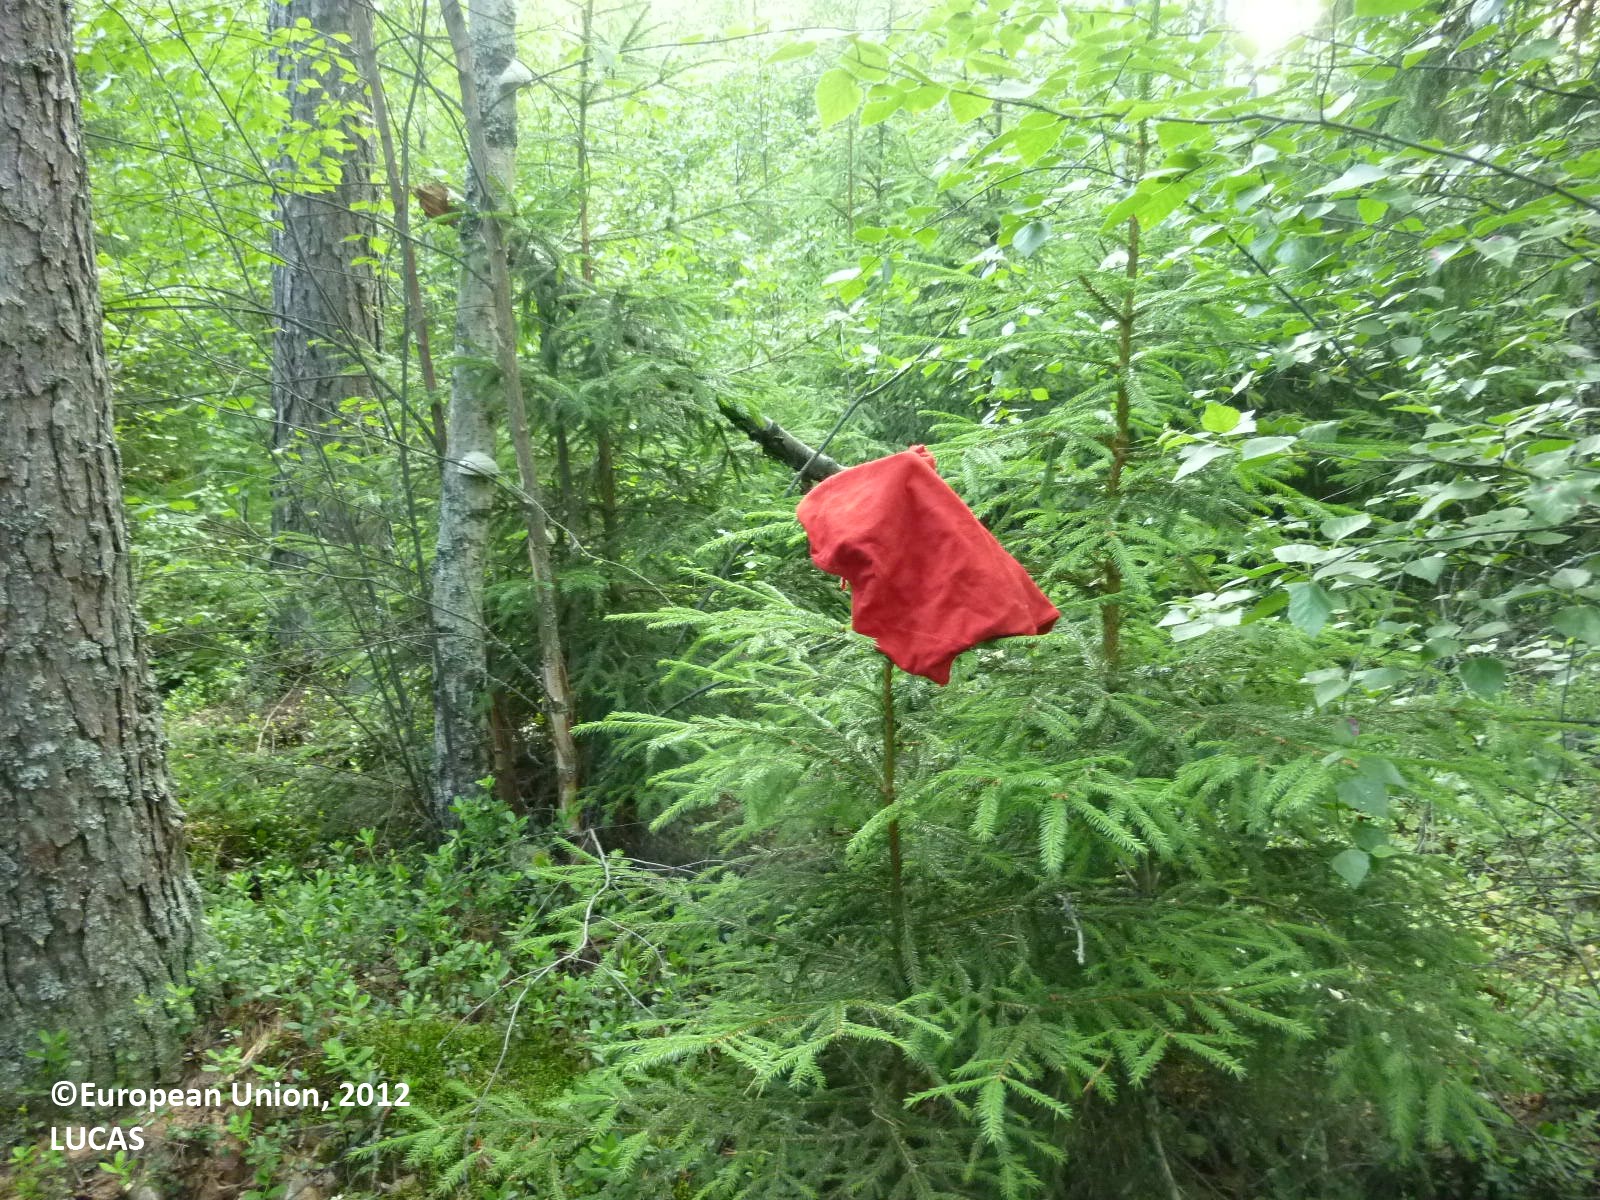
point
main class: Woodland
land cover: Other mixed woodland
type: boreal forest
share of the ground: > 75 %
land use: Forestry
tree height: > 5 m
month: July
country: FI
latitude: 61.3638
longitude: 22.4274
